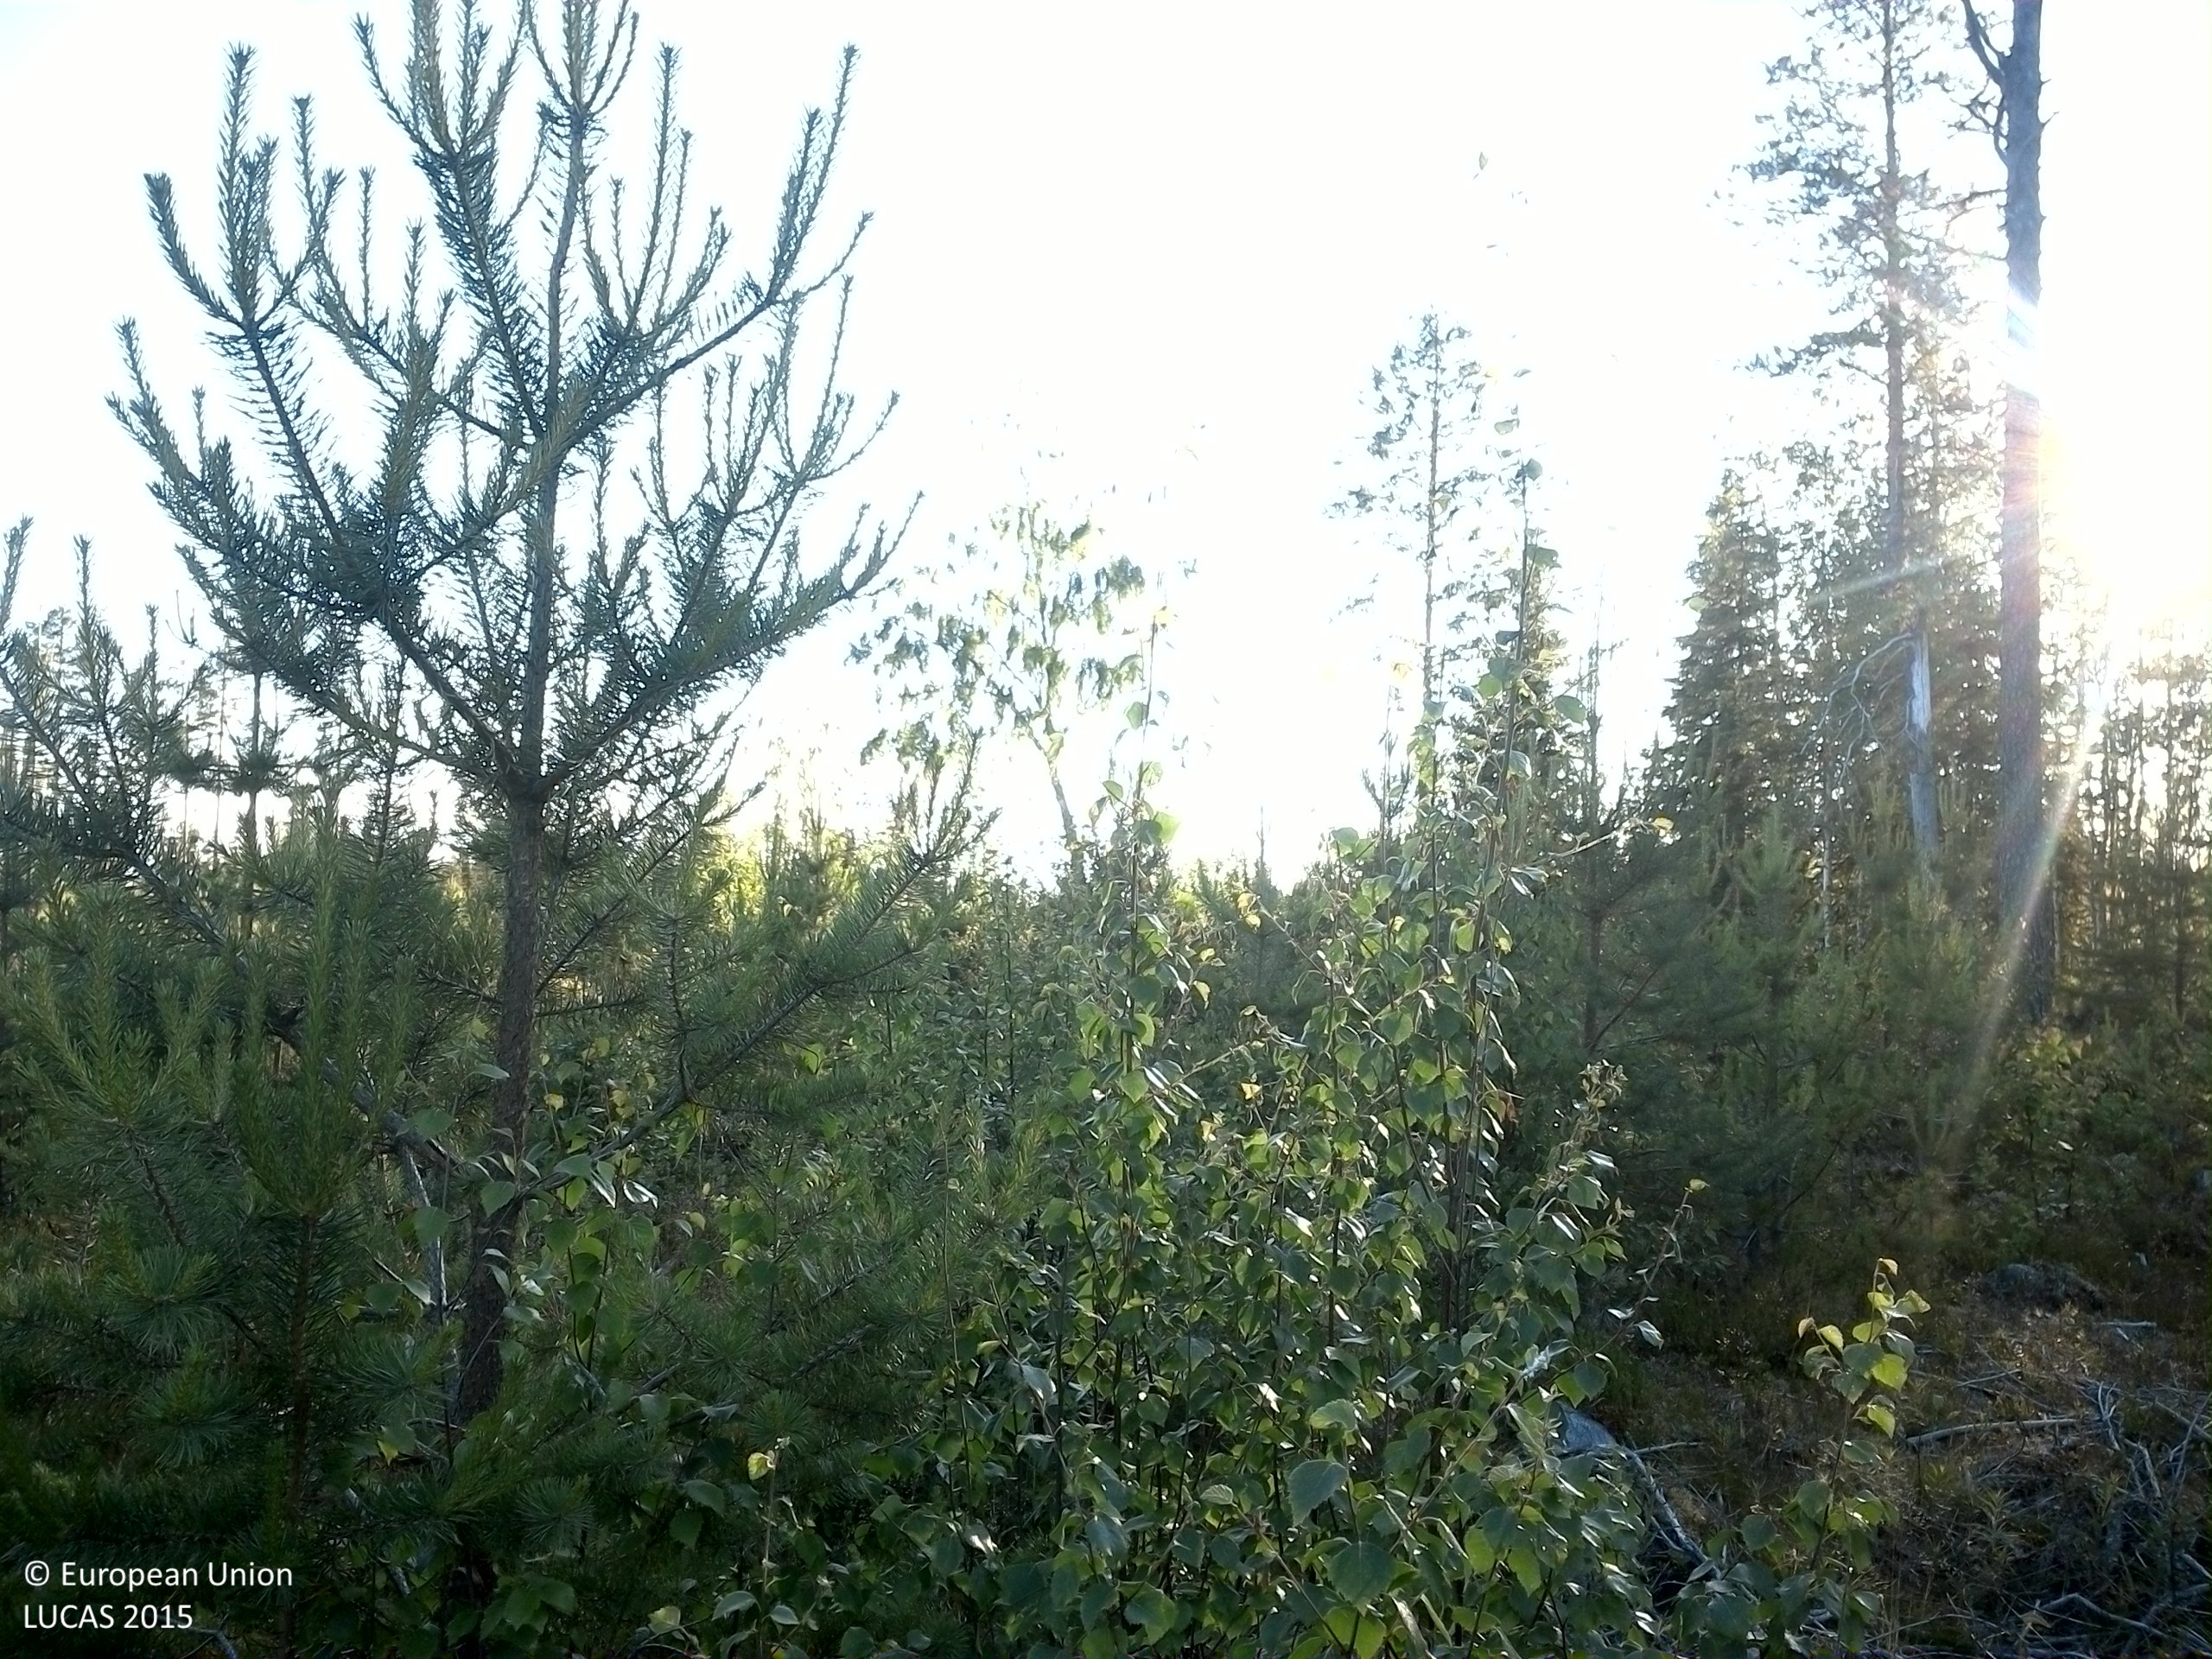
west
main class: Woodland
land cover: Pine dominated mixed woodland
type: boreal forest
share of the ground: 50 - 75 %
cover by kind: coniferous forest trees 45 %, herbaceous plants 20 %, broadleaved forest trees 15 %, shrubs 10 %, lichens and mosses 10 %
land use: Forestry
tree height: < 5 m
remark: Clear cut
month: July
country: SE
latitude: 63.6560
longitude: 17.5472
